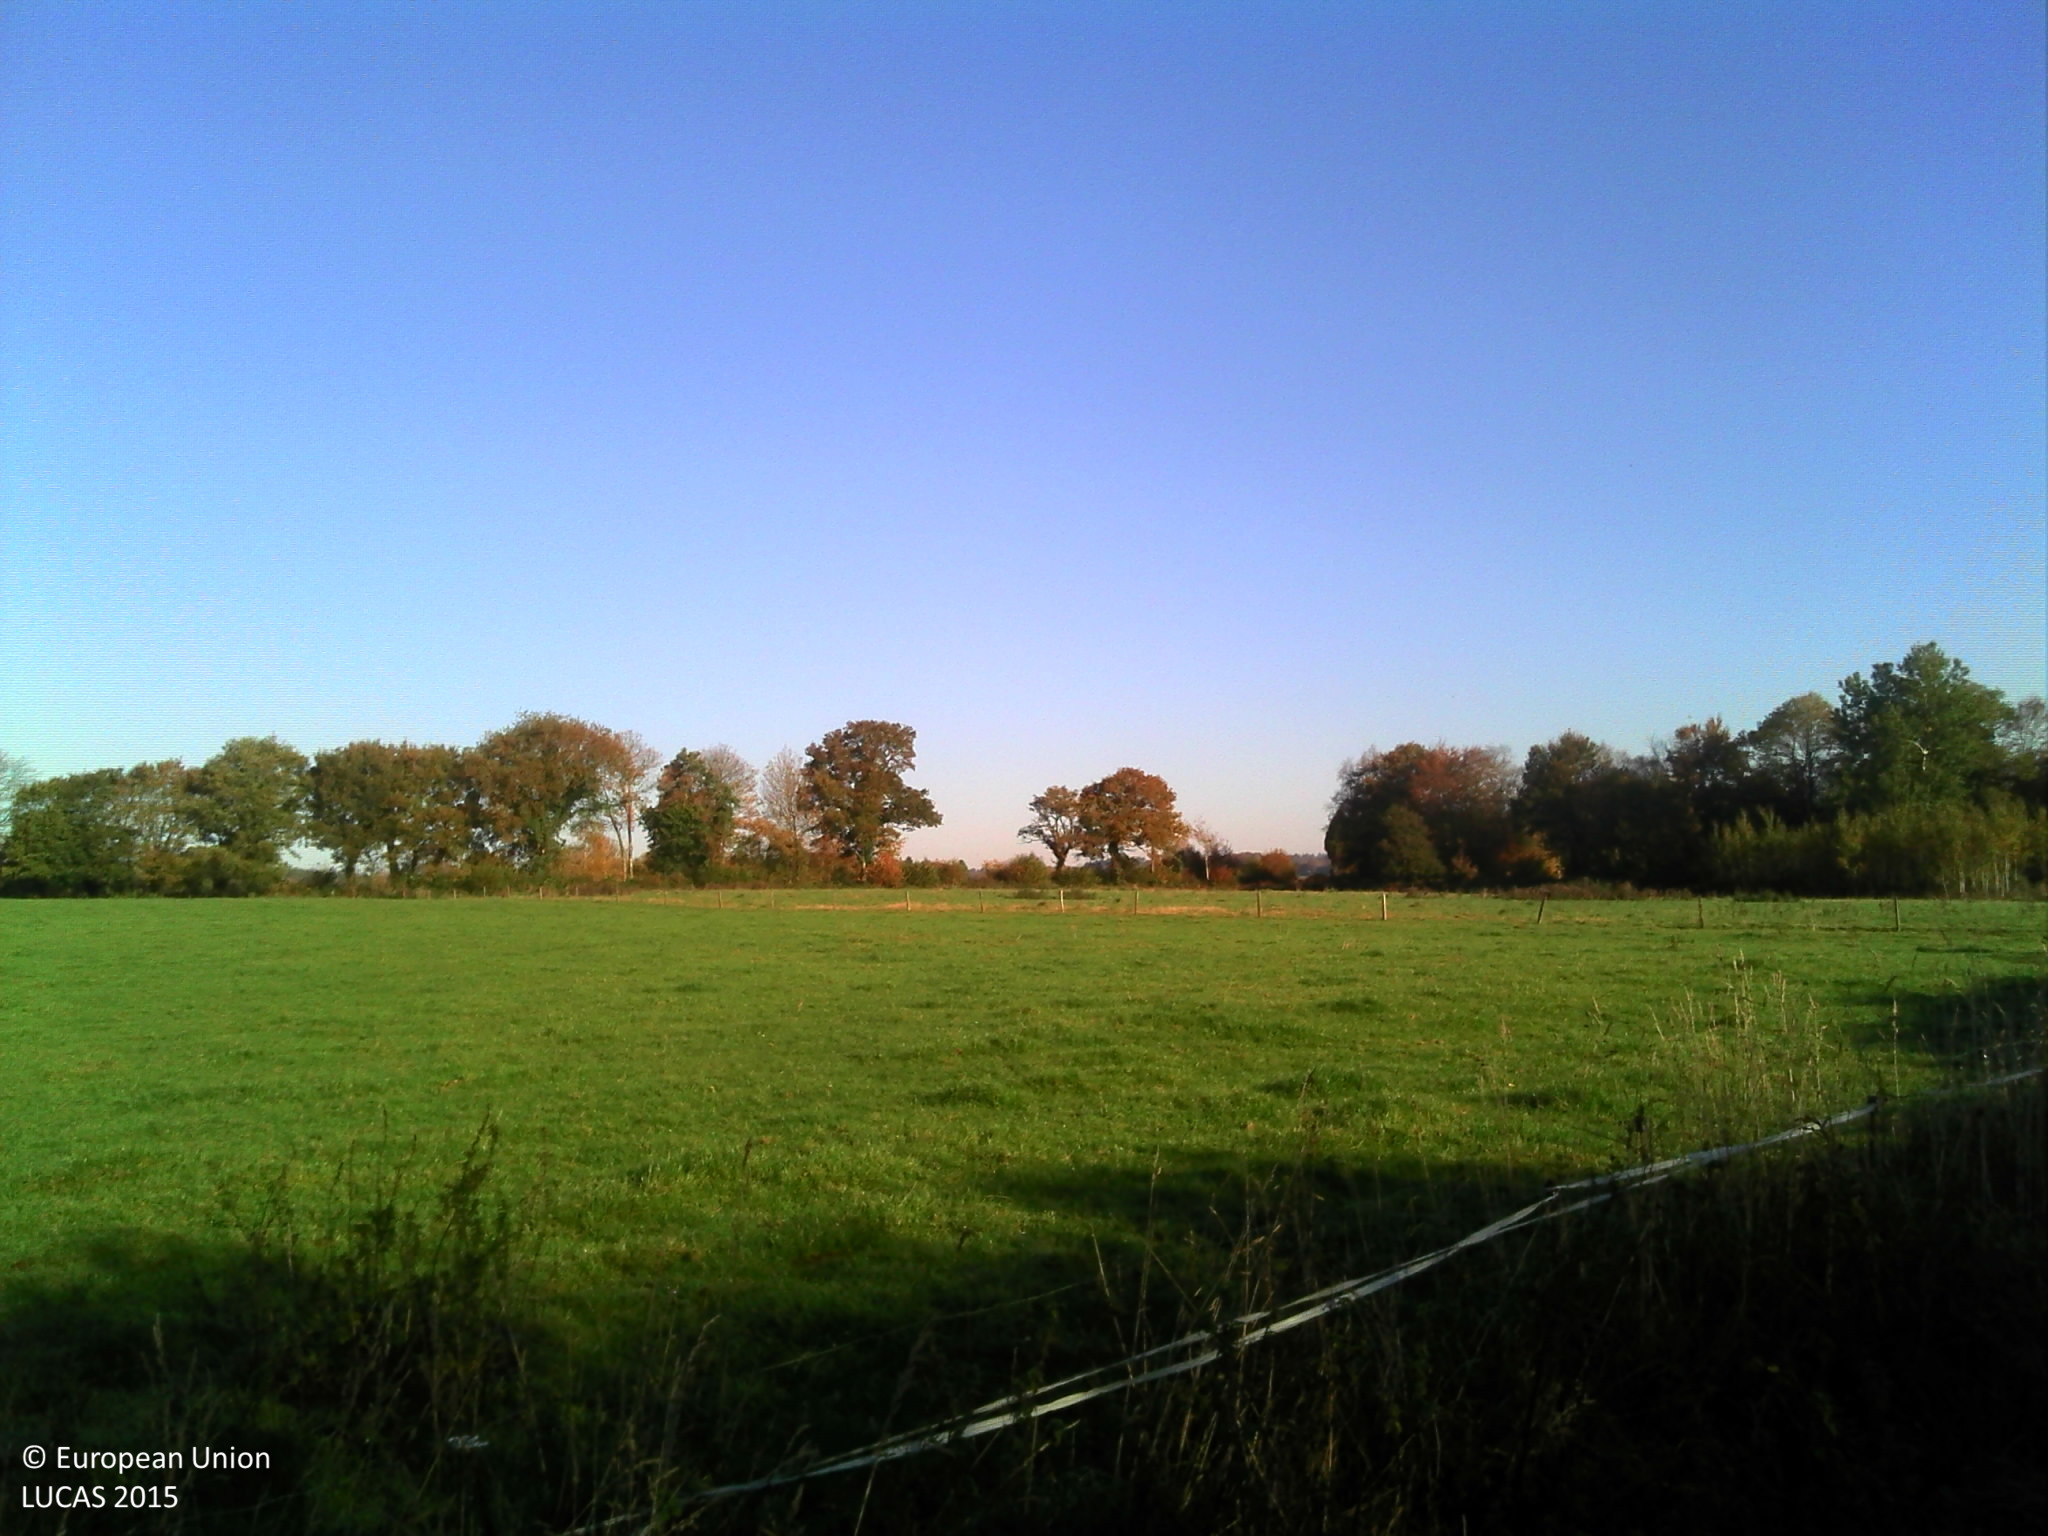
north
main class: Grassland
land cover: Grassland without tree/shrub cover
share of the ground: > 75 %
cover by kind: herbaceous plants 100 %
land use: Agriculture (excluding fallow land and kitchen gardens)
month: November
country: FR
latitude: 48.1027
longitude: -3.3286
